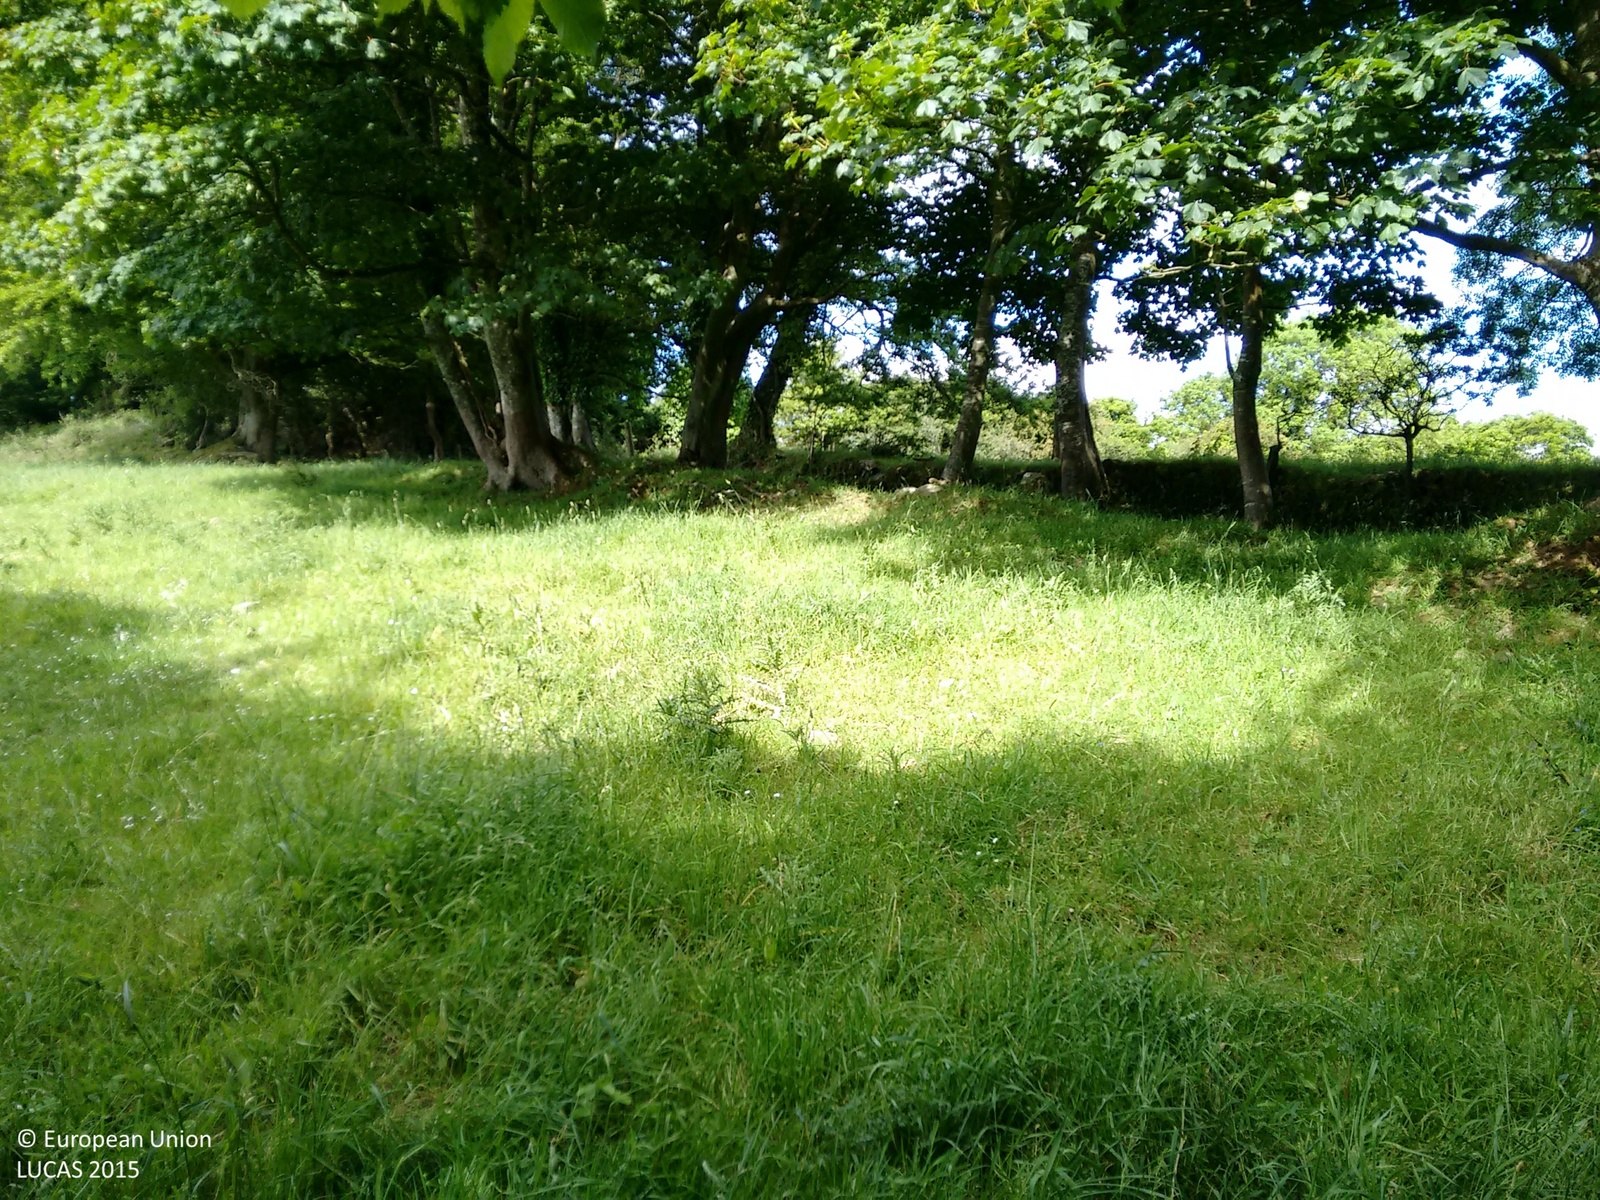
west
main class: Woodland
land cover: Broadleaved woodland
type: acidophilous oak and oak-birch forest
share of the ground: > 75 %
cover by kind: broadleaved forest trees 95 %, shrubs 5 %
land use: Semi-natural and natural areas not in use
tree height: > 5 m
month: June
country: IE
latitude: 52.1655
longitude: -7.3924
